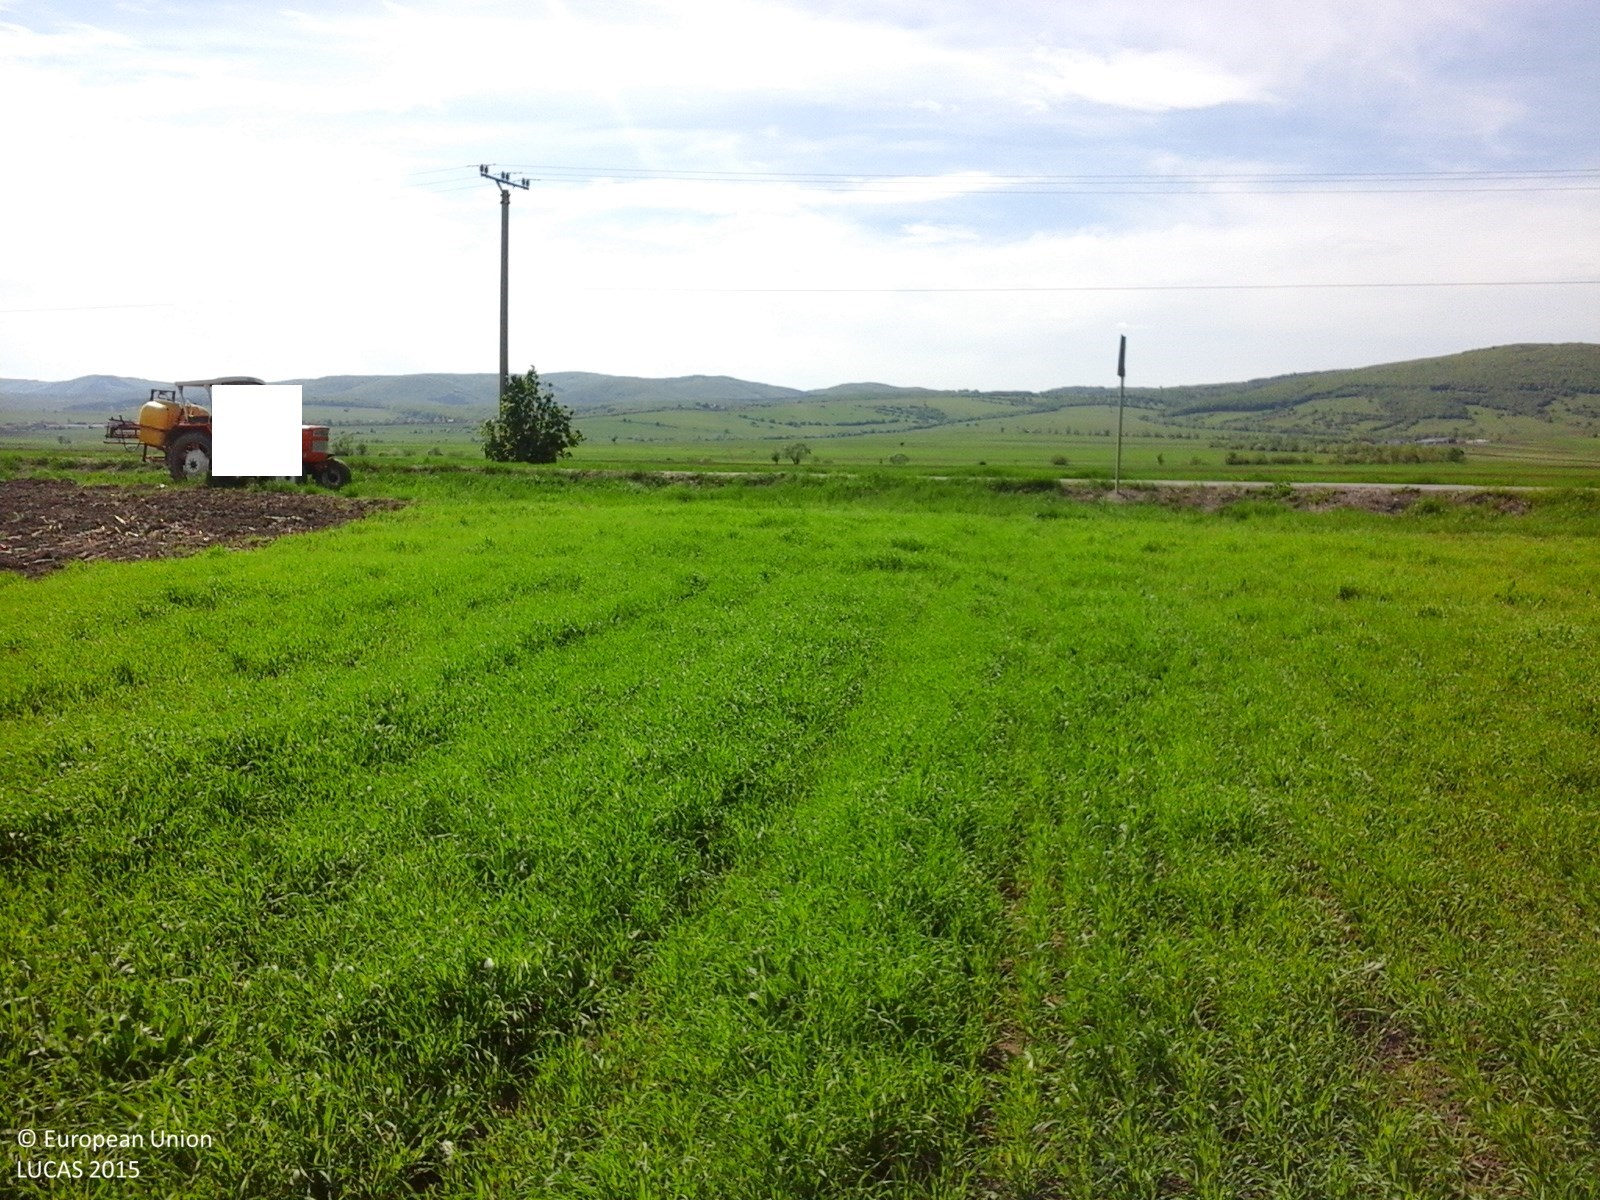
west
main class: Cropland
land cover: Common wheat
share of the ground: > 75 %
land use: Agriculture (excluding fallow land and kitchen gardens)
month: May
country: RO
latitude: 45.9327
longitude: 25.8336
